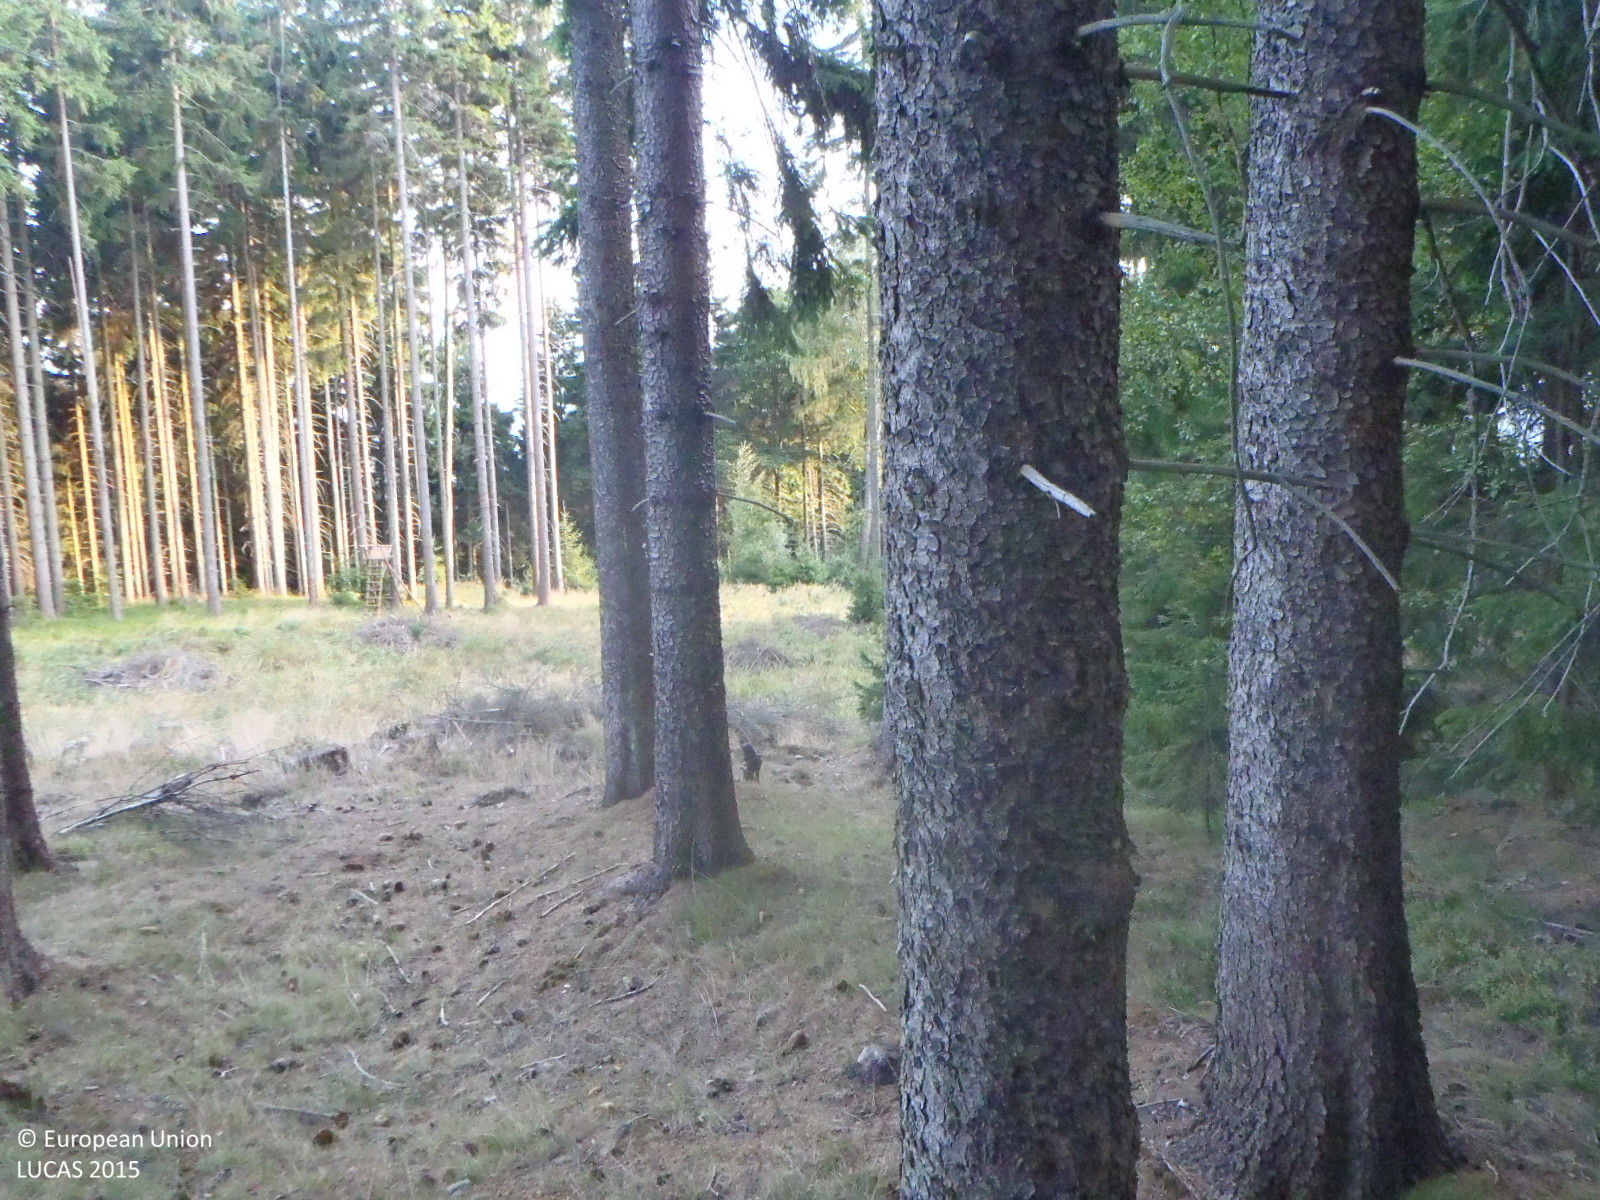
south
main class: Woodland
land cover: Spruce dominated coniferous woodland
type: hemiboreal forest and nemoral coniferous forest and mixed broadleaved-coniferous forest
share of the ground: > 75 %
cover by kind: coniferous forest trees 85 %, broadleaved forest trees 5 %, herbaceous plants 5 %
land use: Forestry
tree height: > 5 m
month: August
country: CZ
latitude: 50.7242
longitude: 14.9750
